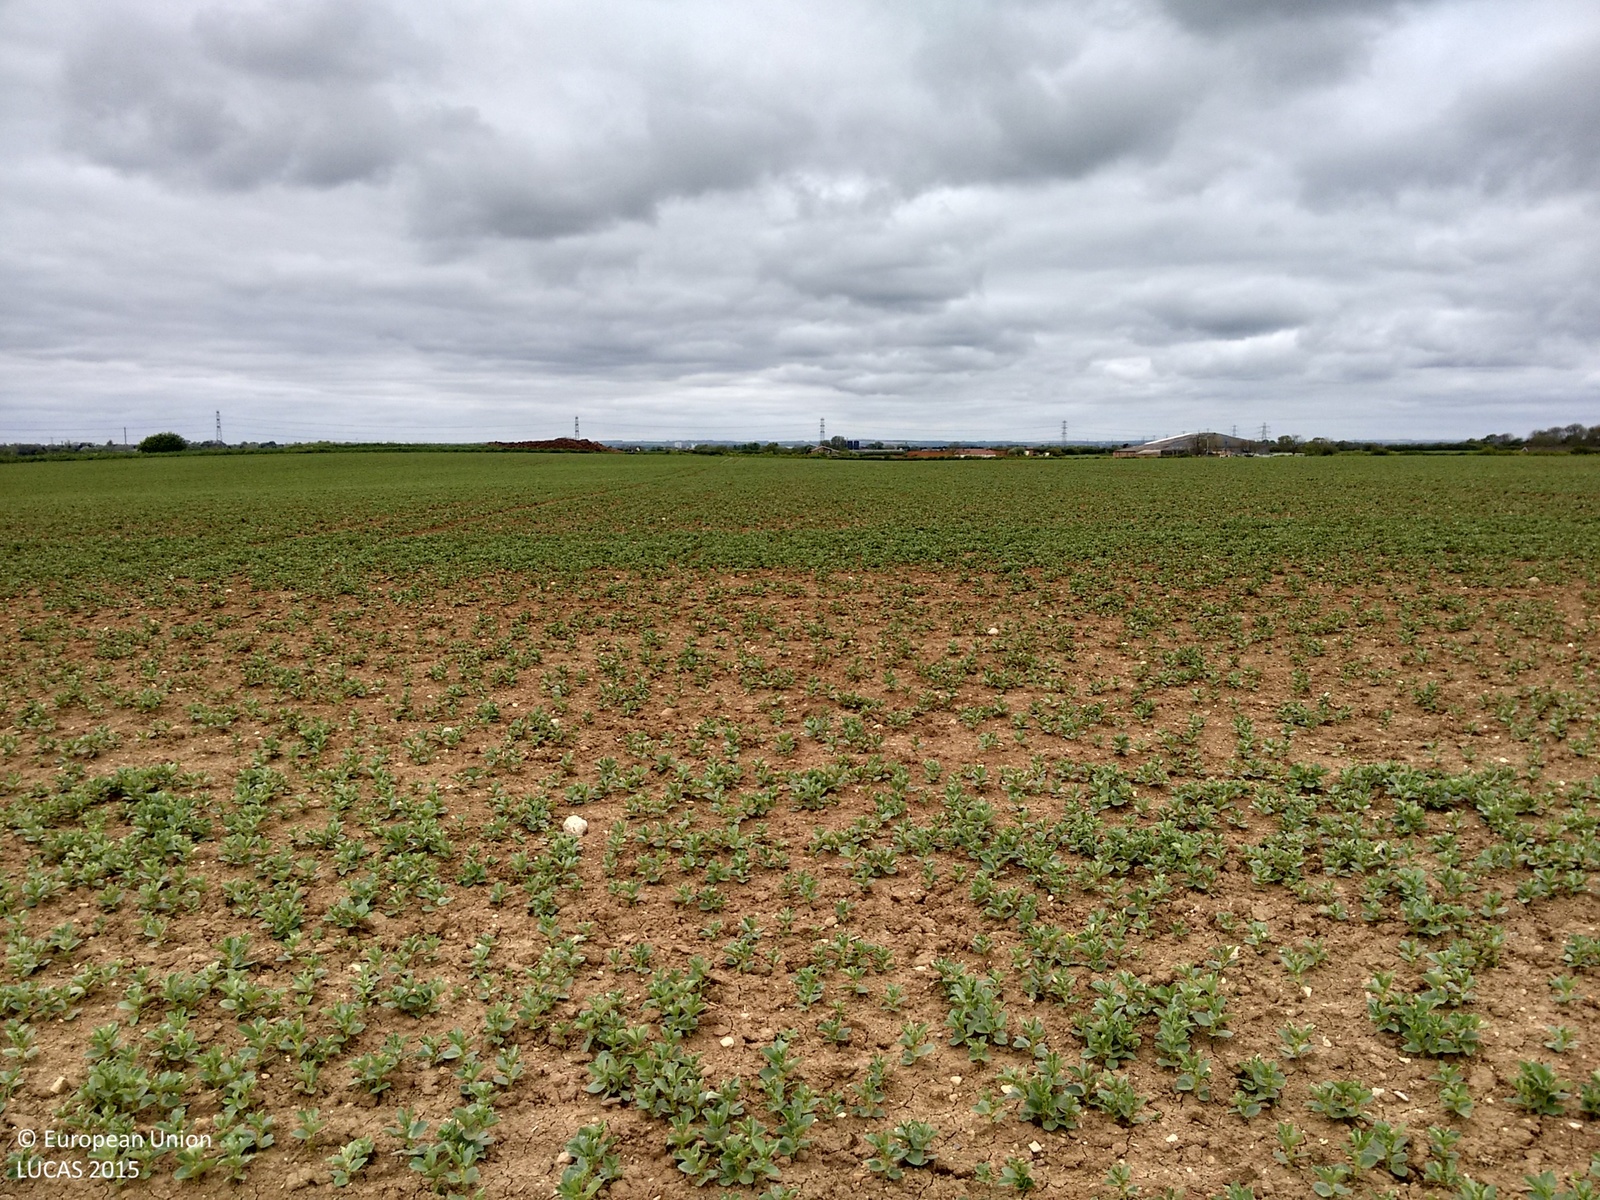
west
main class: Cropland
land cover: Dry pulses
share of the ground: 25 - 50 %
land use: Agriculture (excluding fallow land and kitchen gardens)
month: May
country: GB
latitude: 53.8021
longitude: -0.2219
